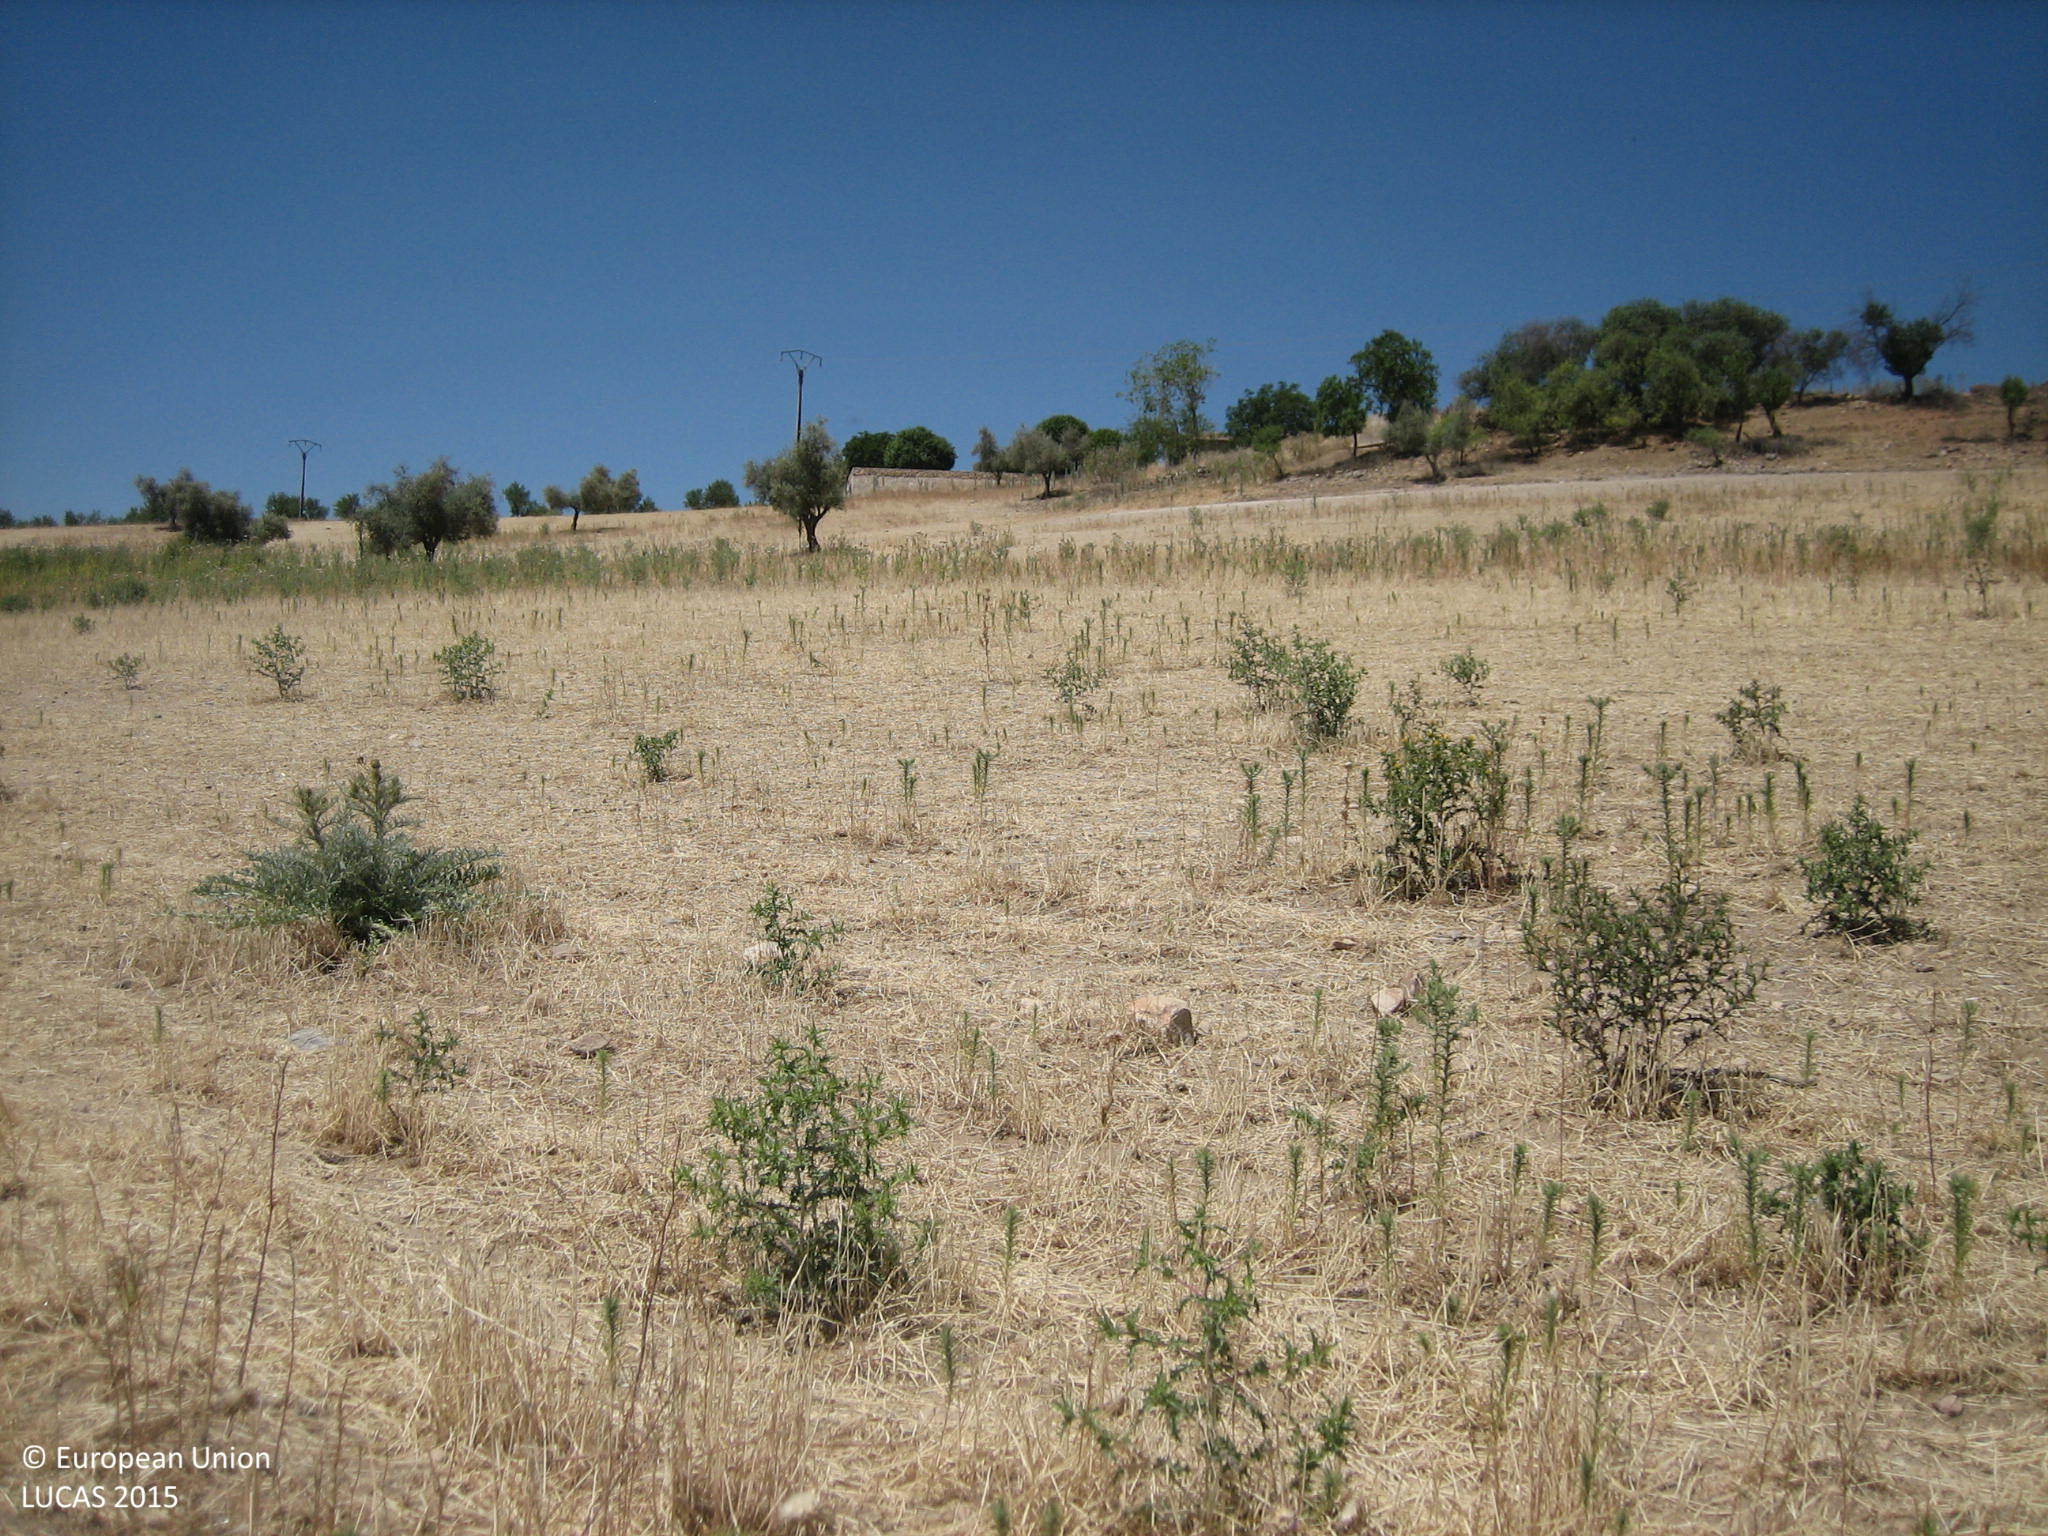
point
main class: Grassland
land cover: Grassland without tree/shrub cover
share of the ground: > 75 %
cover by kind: herbaceous plants 95 %, shrubs 5 %
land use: Agriculture (excluding fallow land and kitchen gardens)
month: May
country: ES
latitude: 38.9228
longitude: -4.0349
